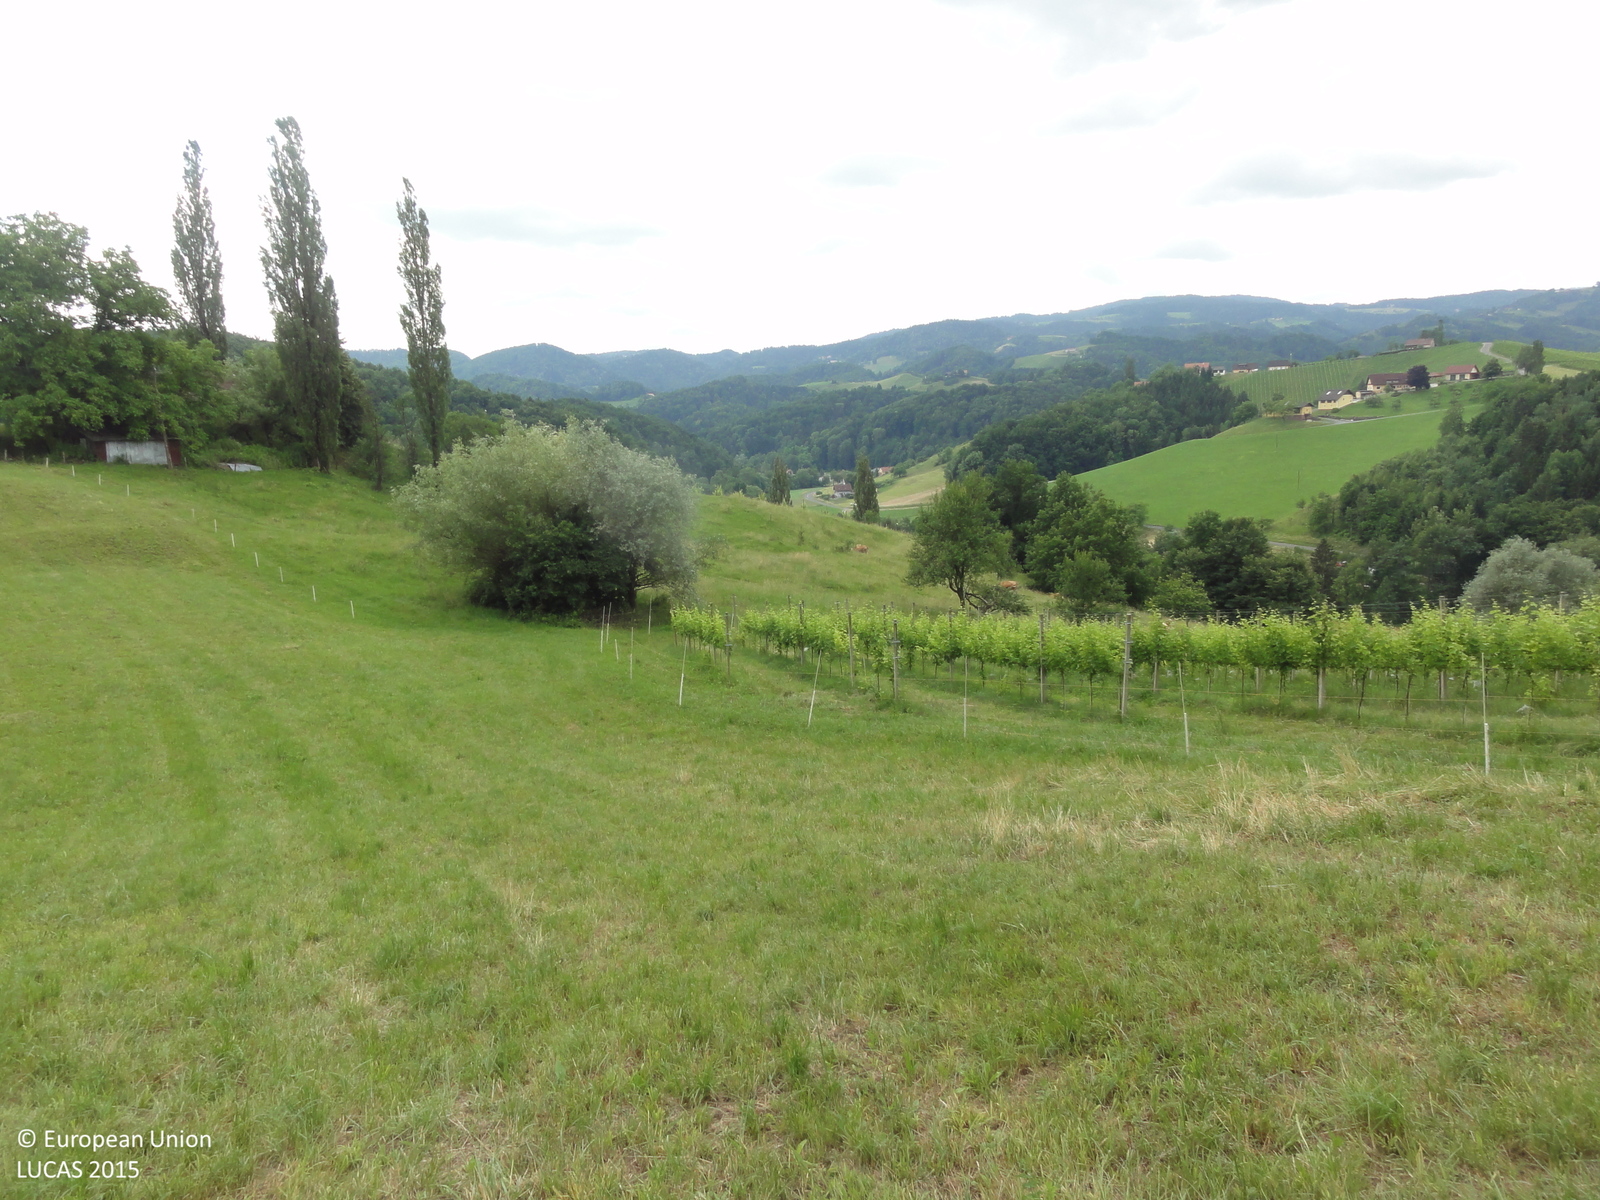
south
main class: Grassland
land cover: Grassland without tree/shrub cover
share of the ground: > 75 %
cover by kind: herbaceous plants 100 %
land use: Agriculture (excluding fallow land and kitchen gardens)
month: June
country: SI
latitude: 46.6582
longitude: 15.5531
